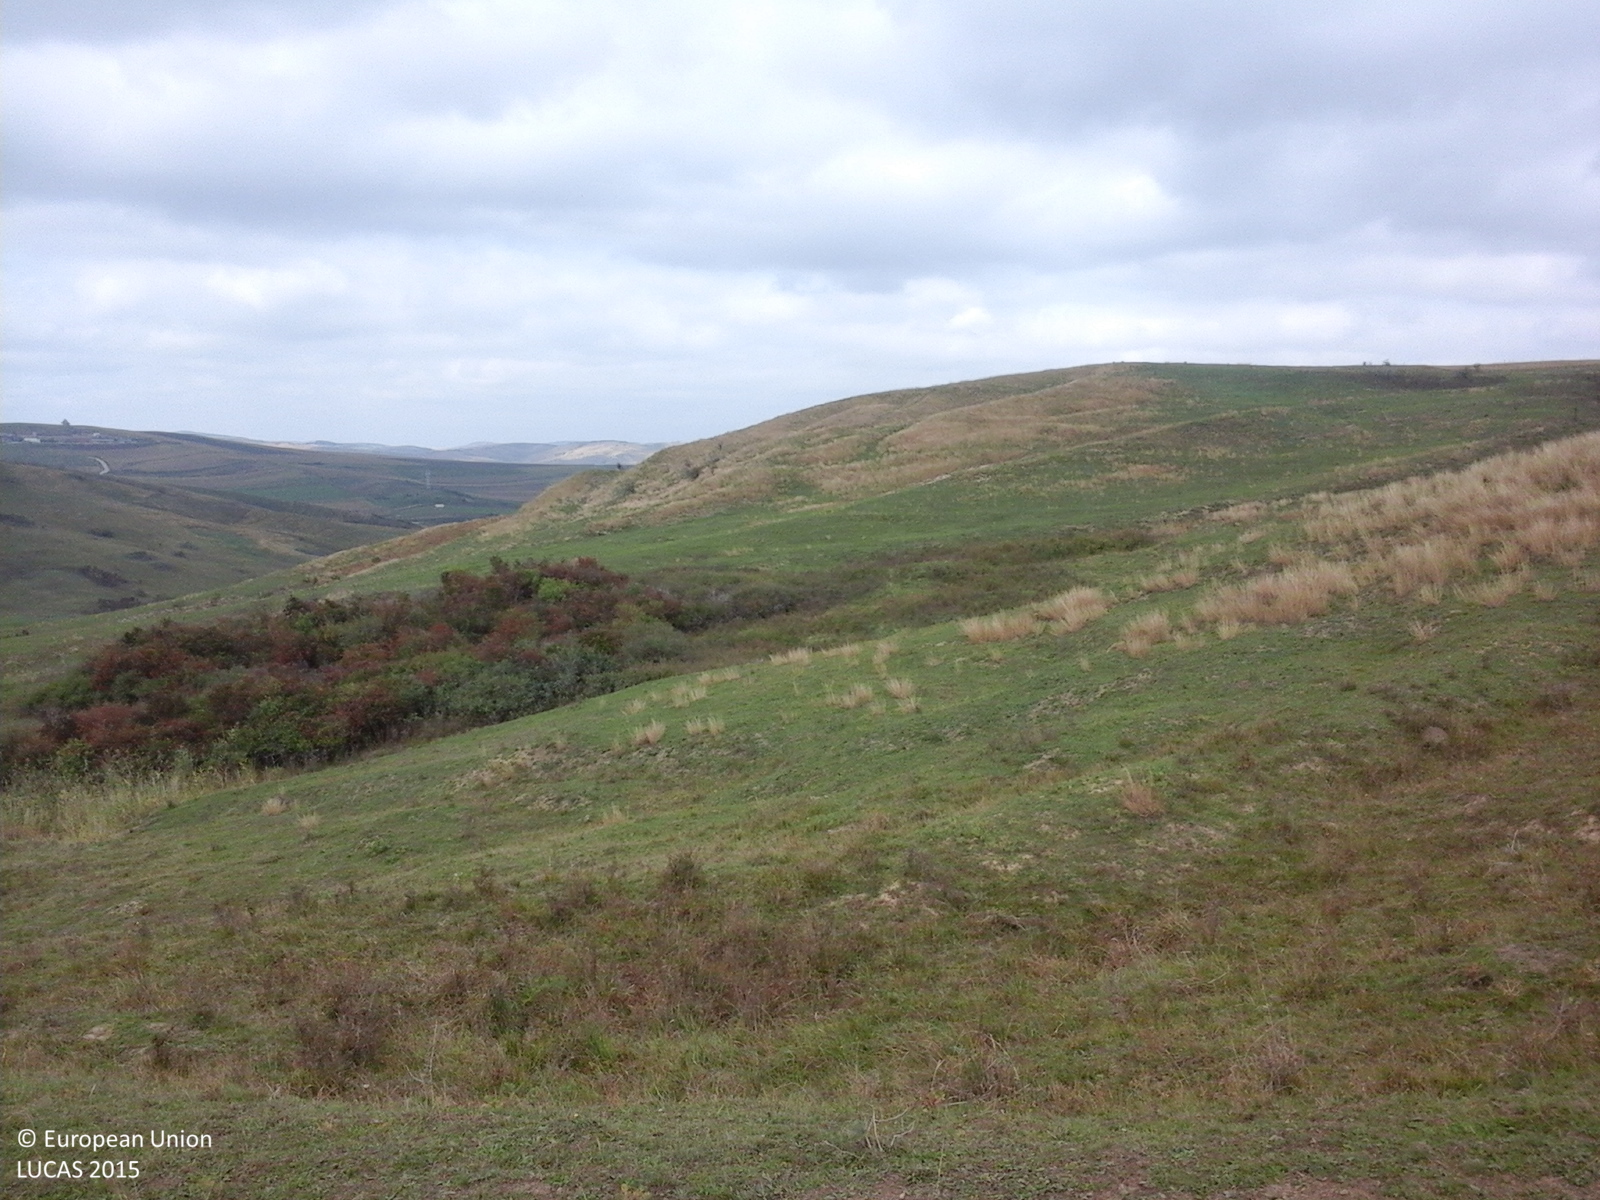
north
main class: Grassland
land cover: Grassland without tree/shrub cover
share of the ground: > 75 %
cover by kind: herbaceous plants 100 %
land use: Agriculture (excluding fallow land and kitchen gardens)
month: October
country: RO
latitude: 46.4245
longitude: 24.0393
